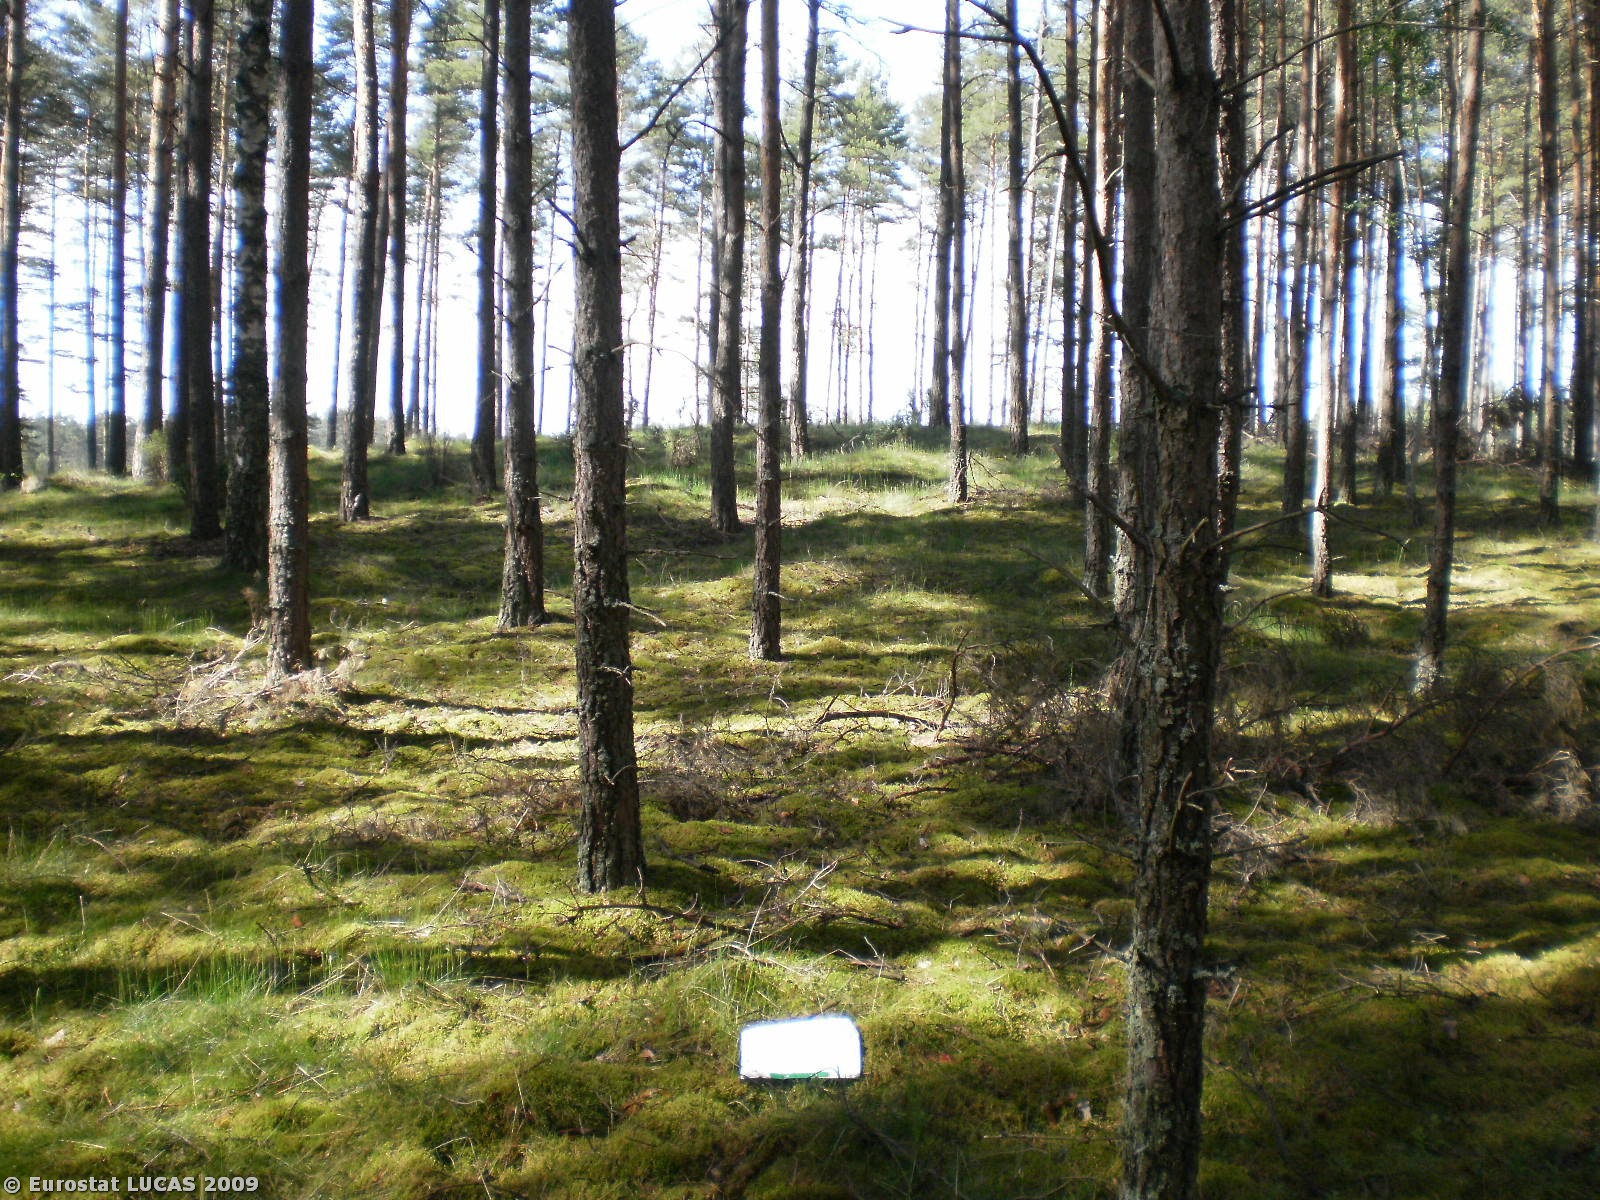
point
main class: Woodland
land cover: Coniferous woodland
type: hemiboreal forest and nemoral coniferous forest and mixed broadleaved-coniferous forest
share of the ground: > 75 %
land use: Forestry
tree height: > 5 m
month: May
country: PL
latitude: 53.7132
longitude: 18.0299
